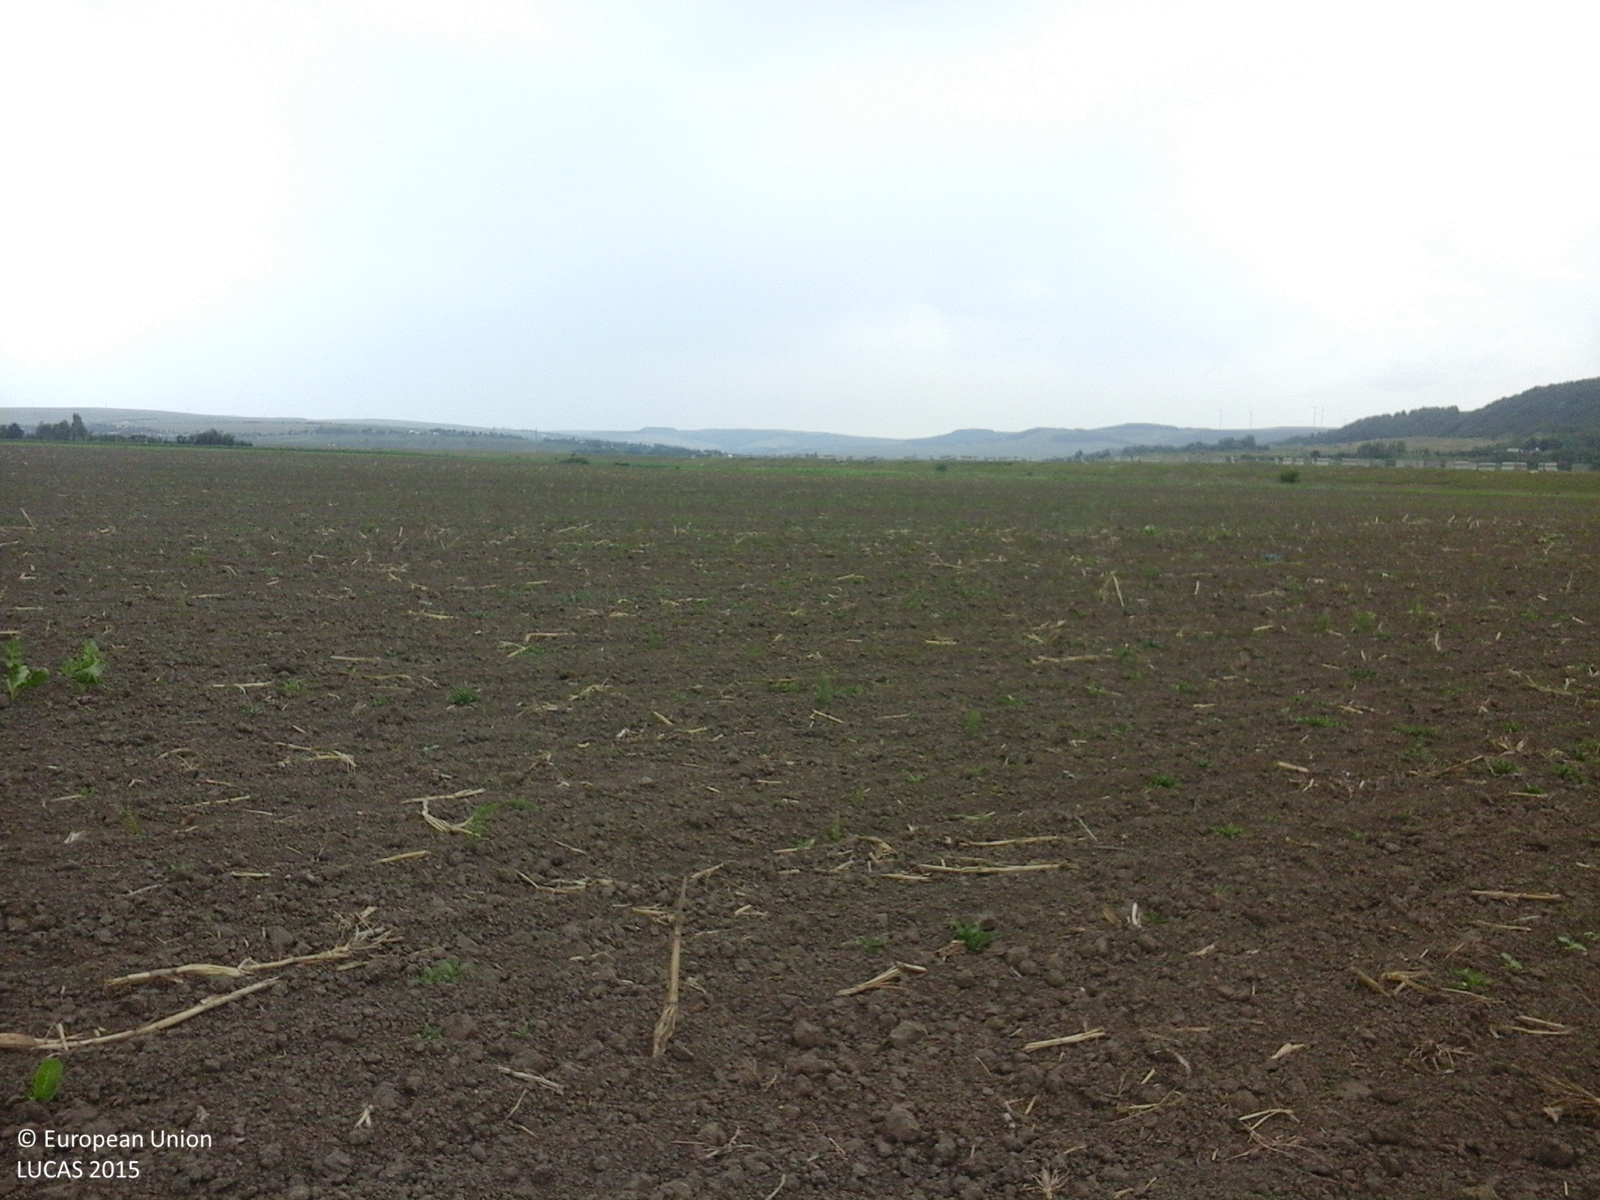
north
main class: Cropland
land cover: Sunflower
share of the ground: < 10 %
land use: Agriculture (excluding fallow land and kitchen gardens)
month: June
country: RO
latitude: 47.3237
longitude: 26.6983
